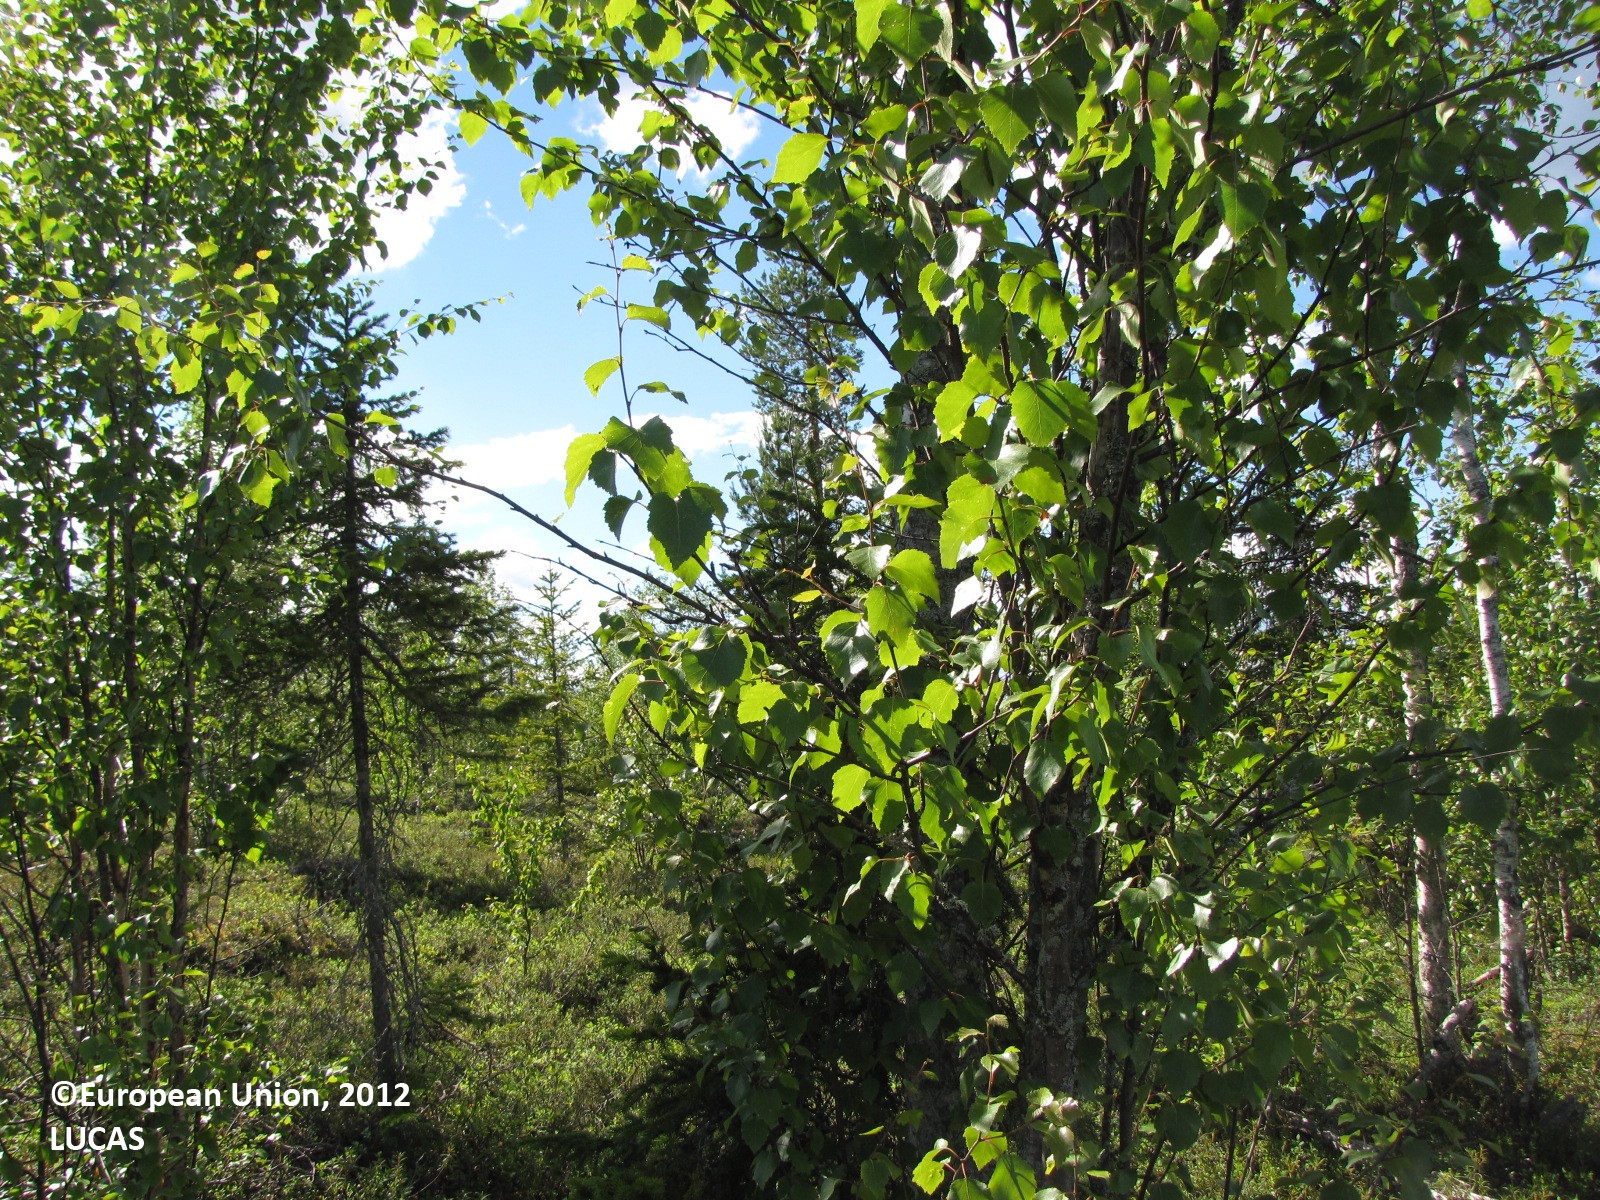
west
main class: Woodland
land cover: Pine dominated mixed woodland
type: boreal forest
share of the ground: 25 - 50 %
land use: Forestry
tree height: > 5 m
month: July
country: FI
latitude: 66.5278
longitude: 24.5571
